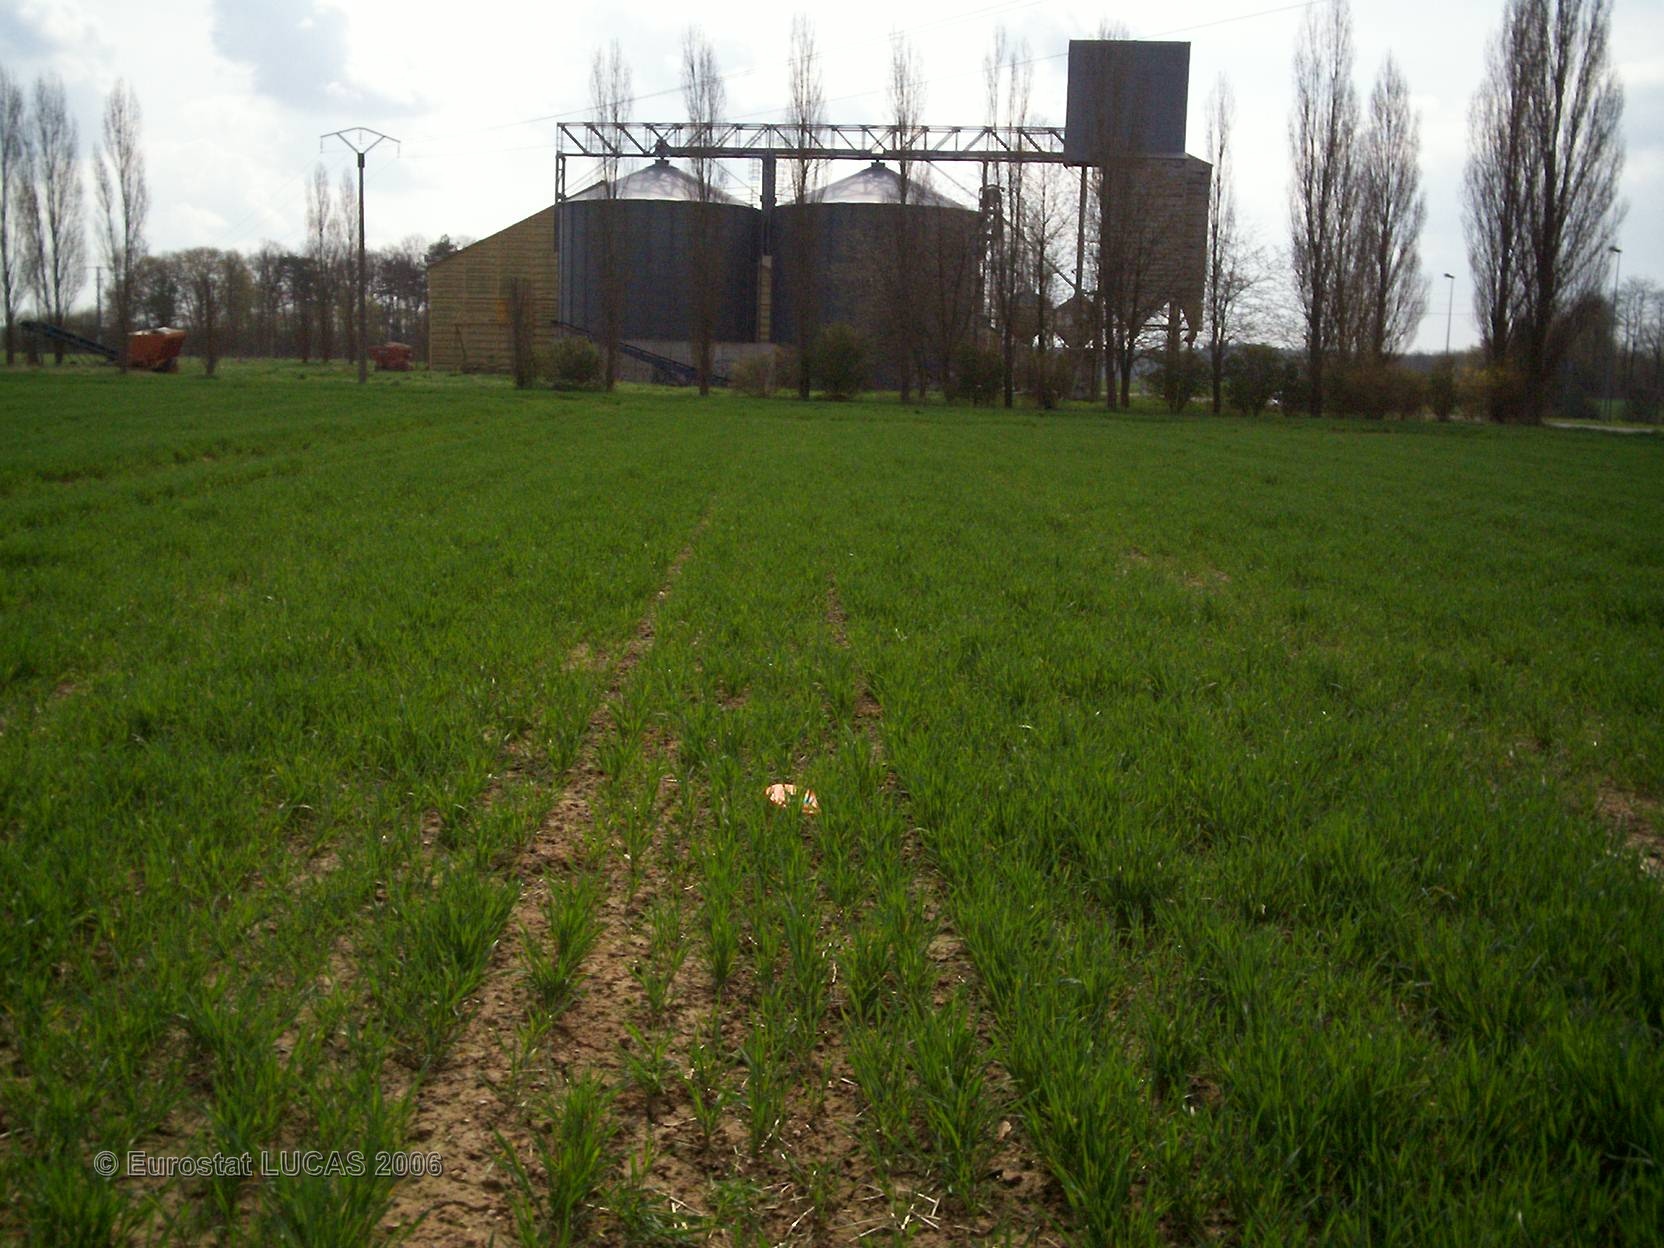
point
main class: Cropland
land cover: Common wheat
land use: Agriculture (excluding fallow land and kitchen gardens)
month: April
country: FR
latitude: 48.9973
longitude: 1.0260
